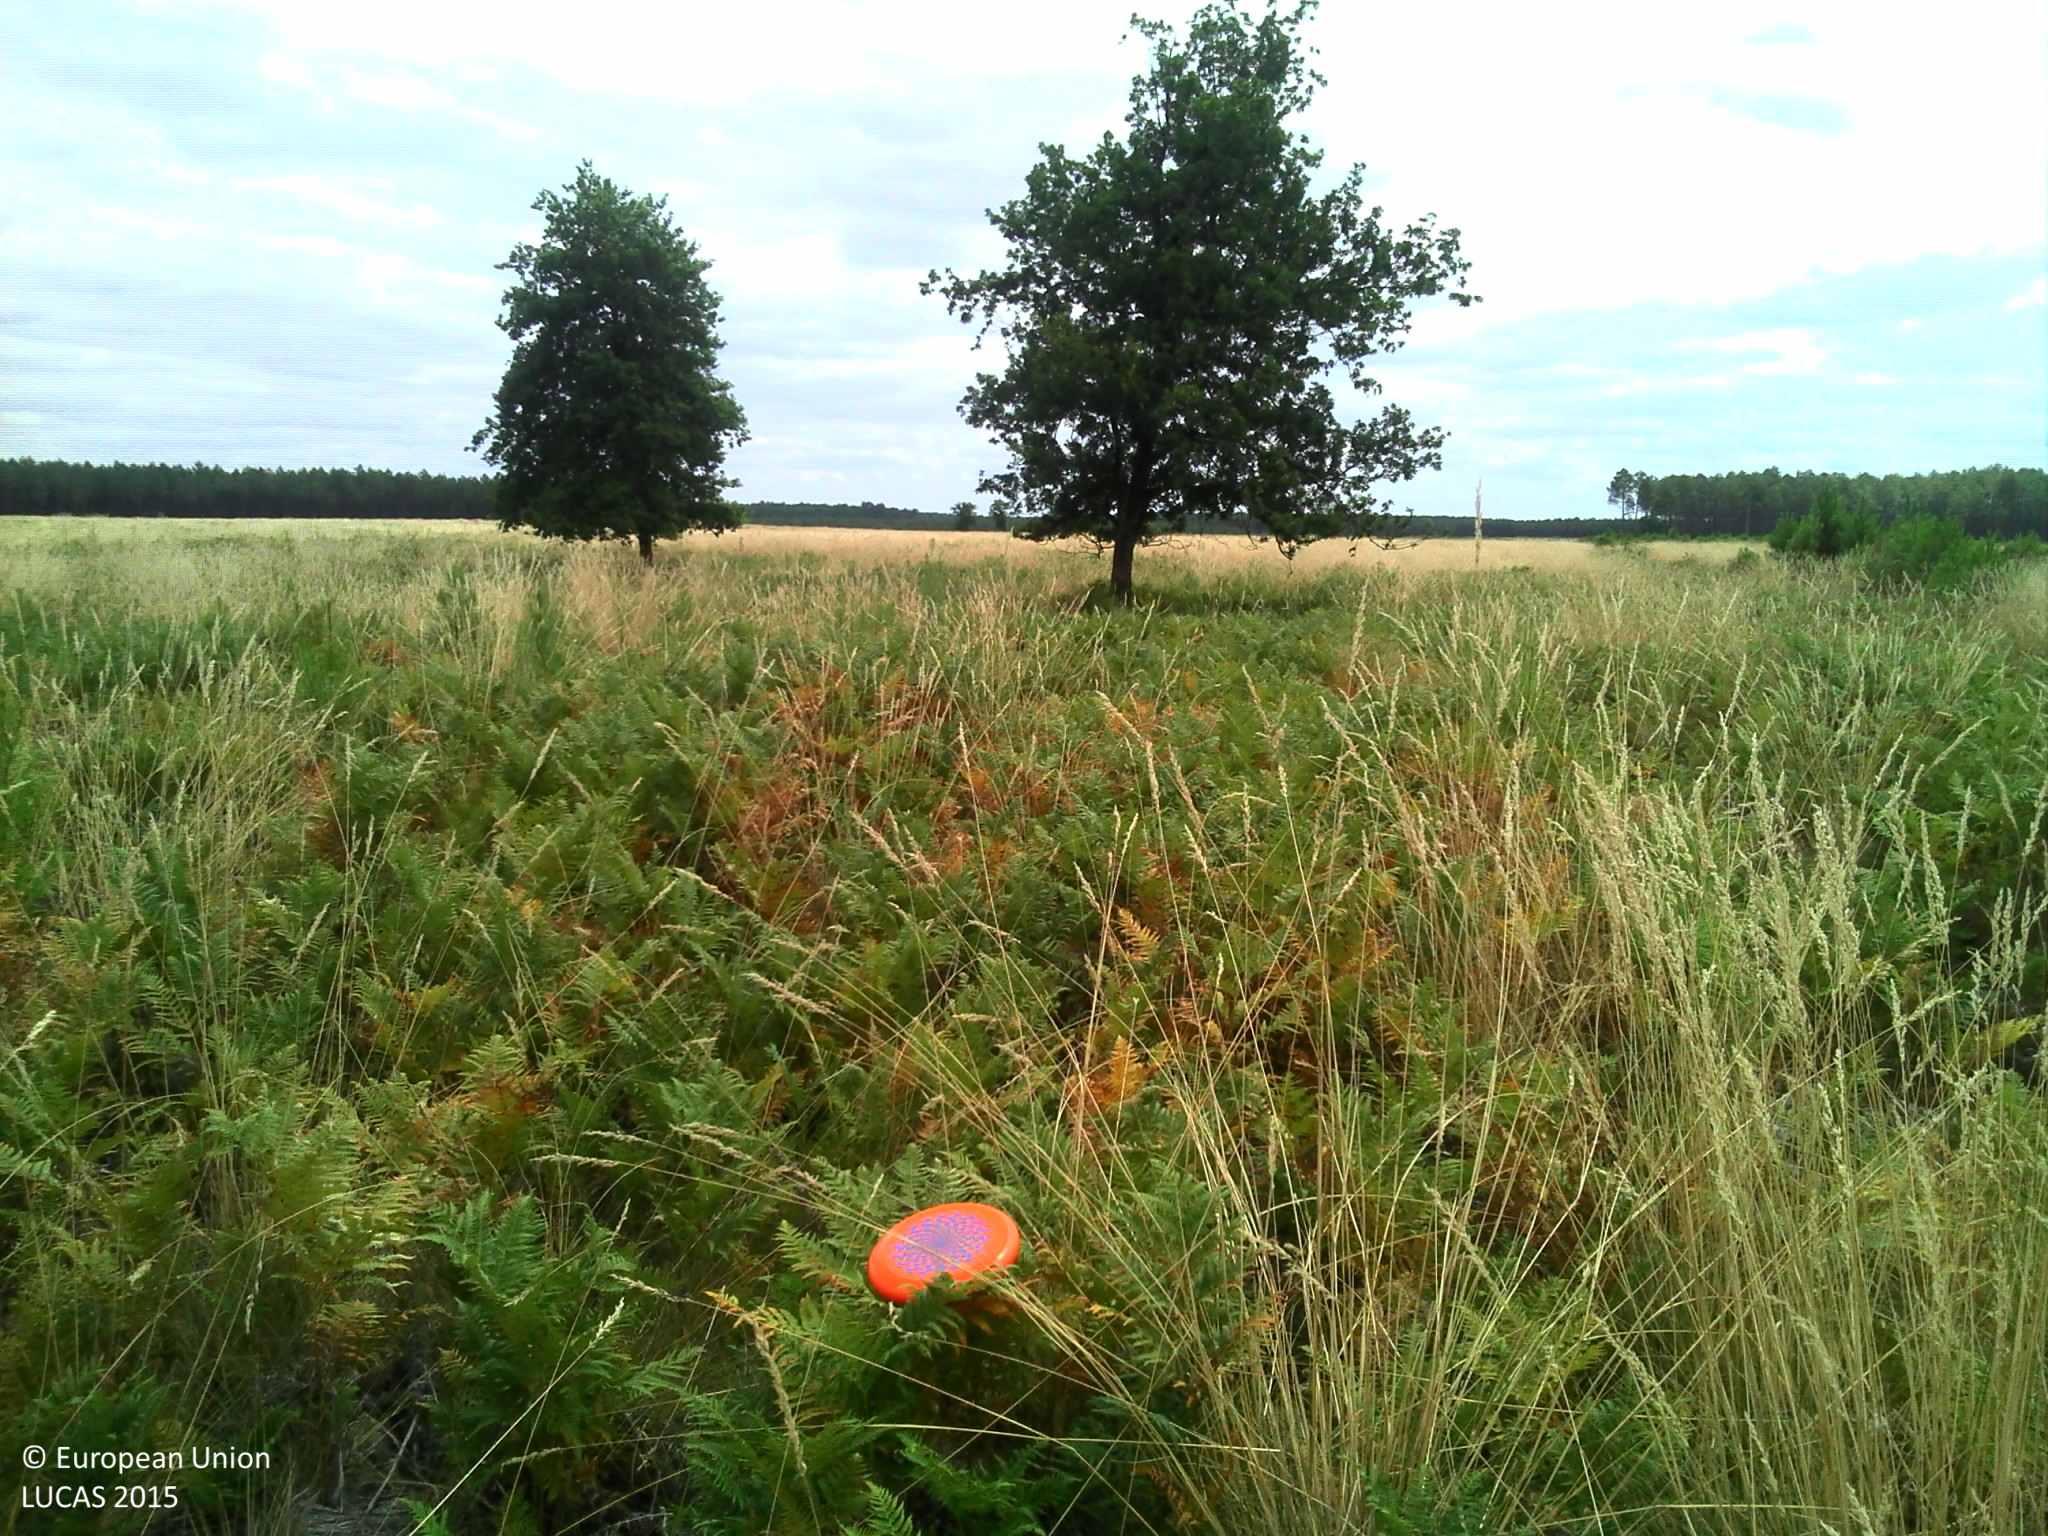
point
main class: Grassland
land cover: Grassland with sparse tree/shrub cover
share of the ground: > 75 %
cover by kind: herbaceous plants 85 %, broadleaved forest trees 5 %, shrubs 5 %, unconsolidated bare surface 5 %
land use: Forestry
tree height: < 5 m
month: July
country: FR
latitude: 43.9581
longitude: -1.2226
